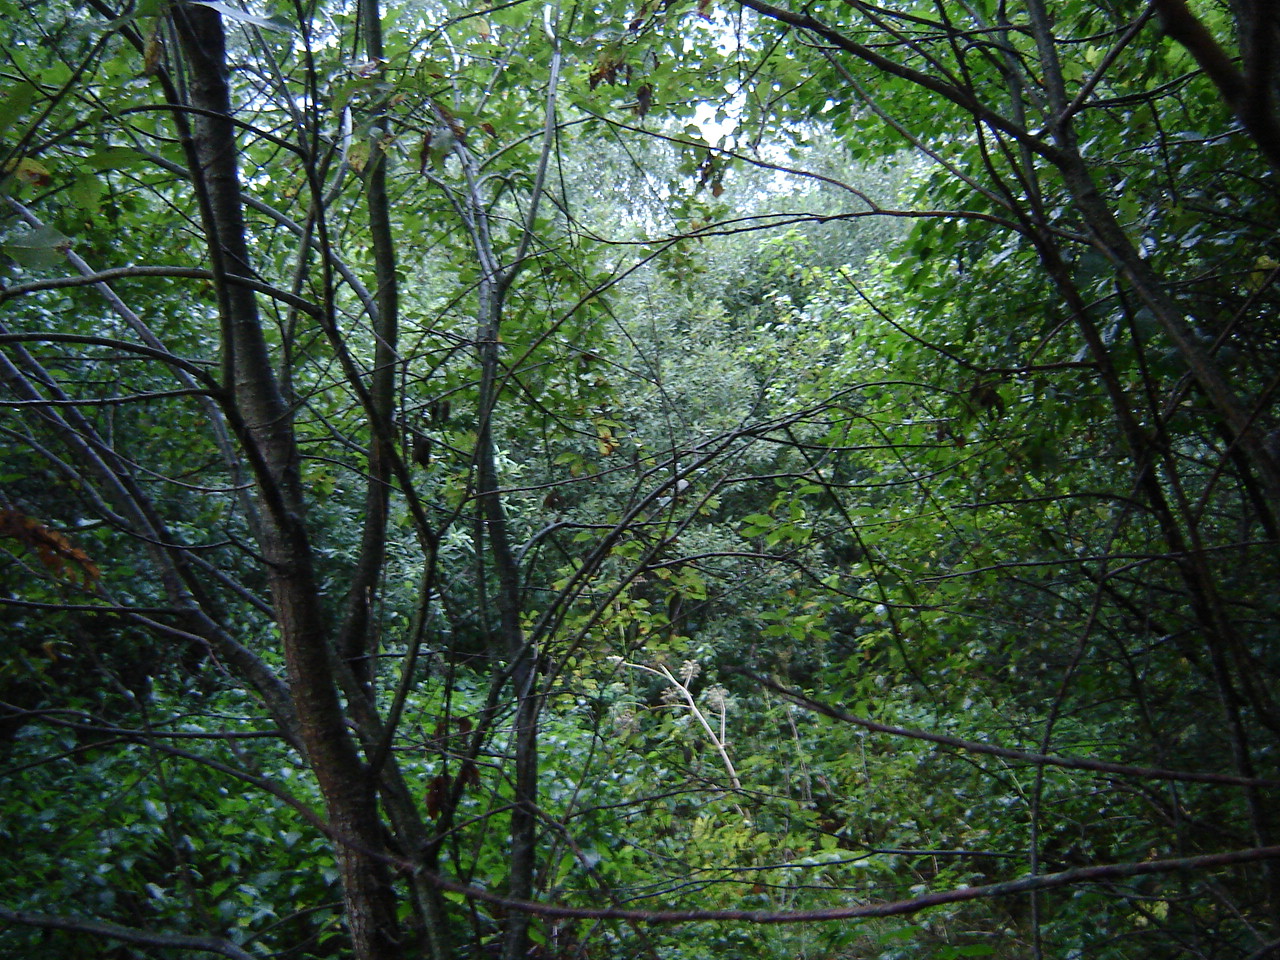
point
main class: Woodland
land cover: Broadleaved woodland
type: mire and swamp forests
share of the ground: > 75 %
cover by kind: broadleaved forest trees 95 %, coniferous forest trees 5 %
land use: Forestry
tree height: > 5 m
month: September
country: LT
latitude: 54.9839
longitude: 25.3264
